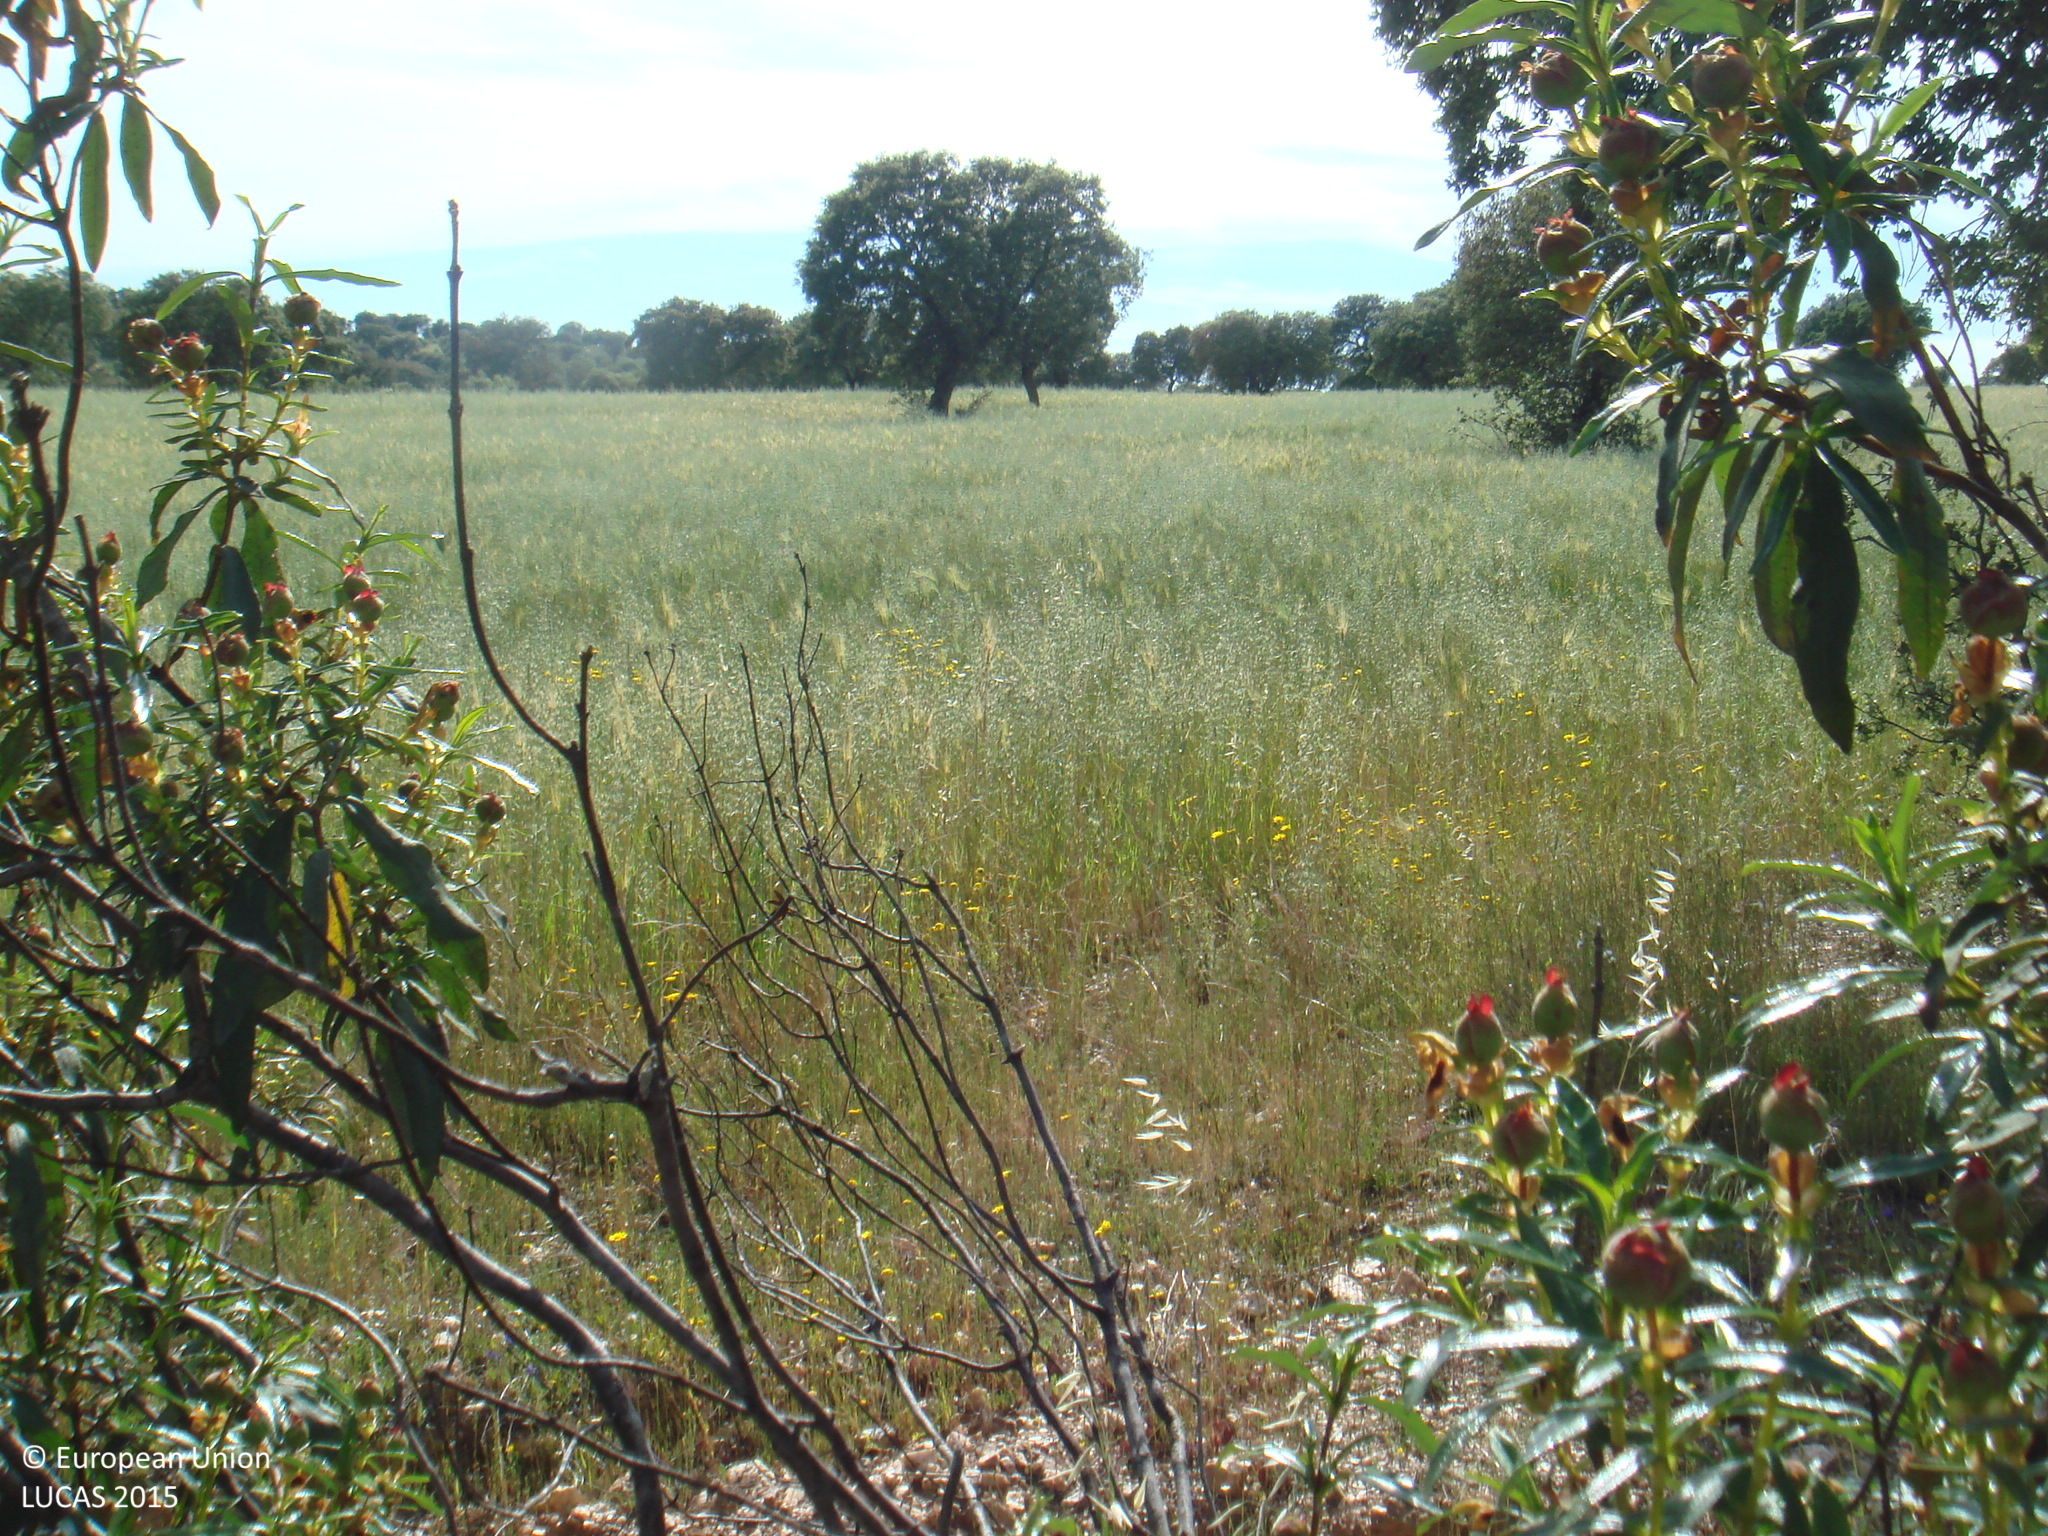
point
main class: Woodland
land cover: Broadleaved woodland
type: broadleaved evergreen forest
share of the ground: 10 - 25 %
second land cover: Oats
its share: > 75 %
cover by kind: herbaceous plants 85 %, broadleaved forest trees 15 %
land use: Forestry
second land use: Agriculture (excluding fallow land and kitchen gardens)
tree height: > 5 m
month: April
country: ES
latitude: 38.4094
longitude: -5.1101
